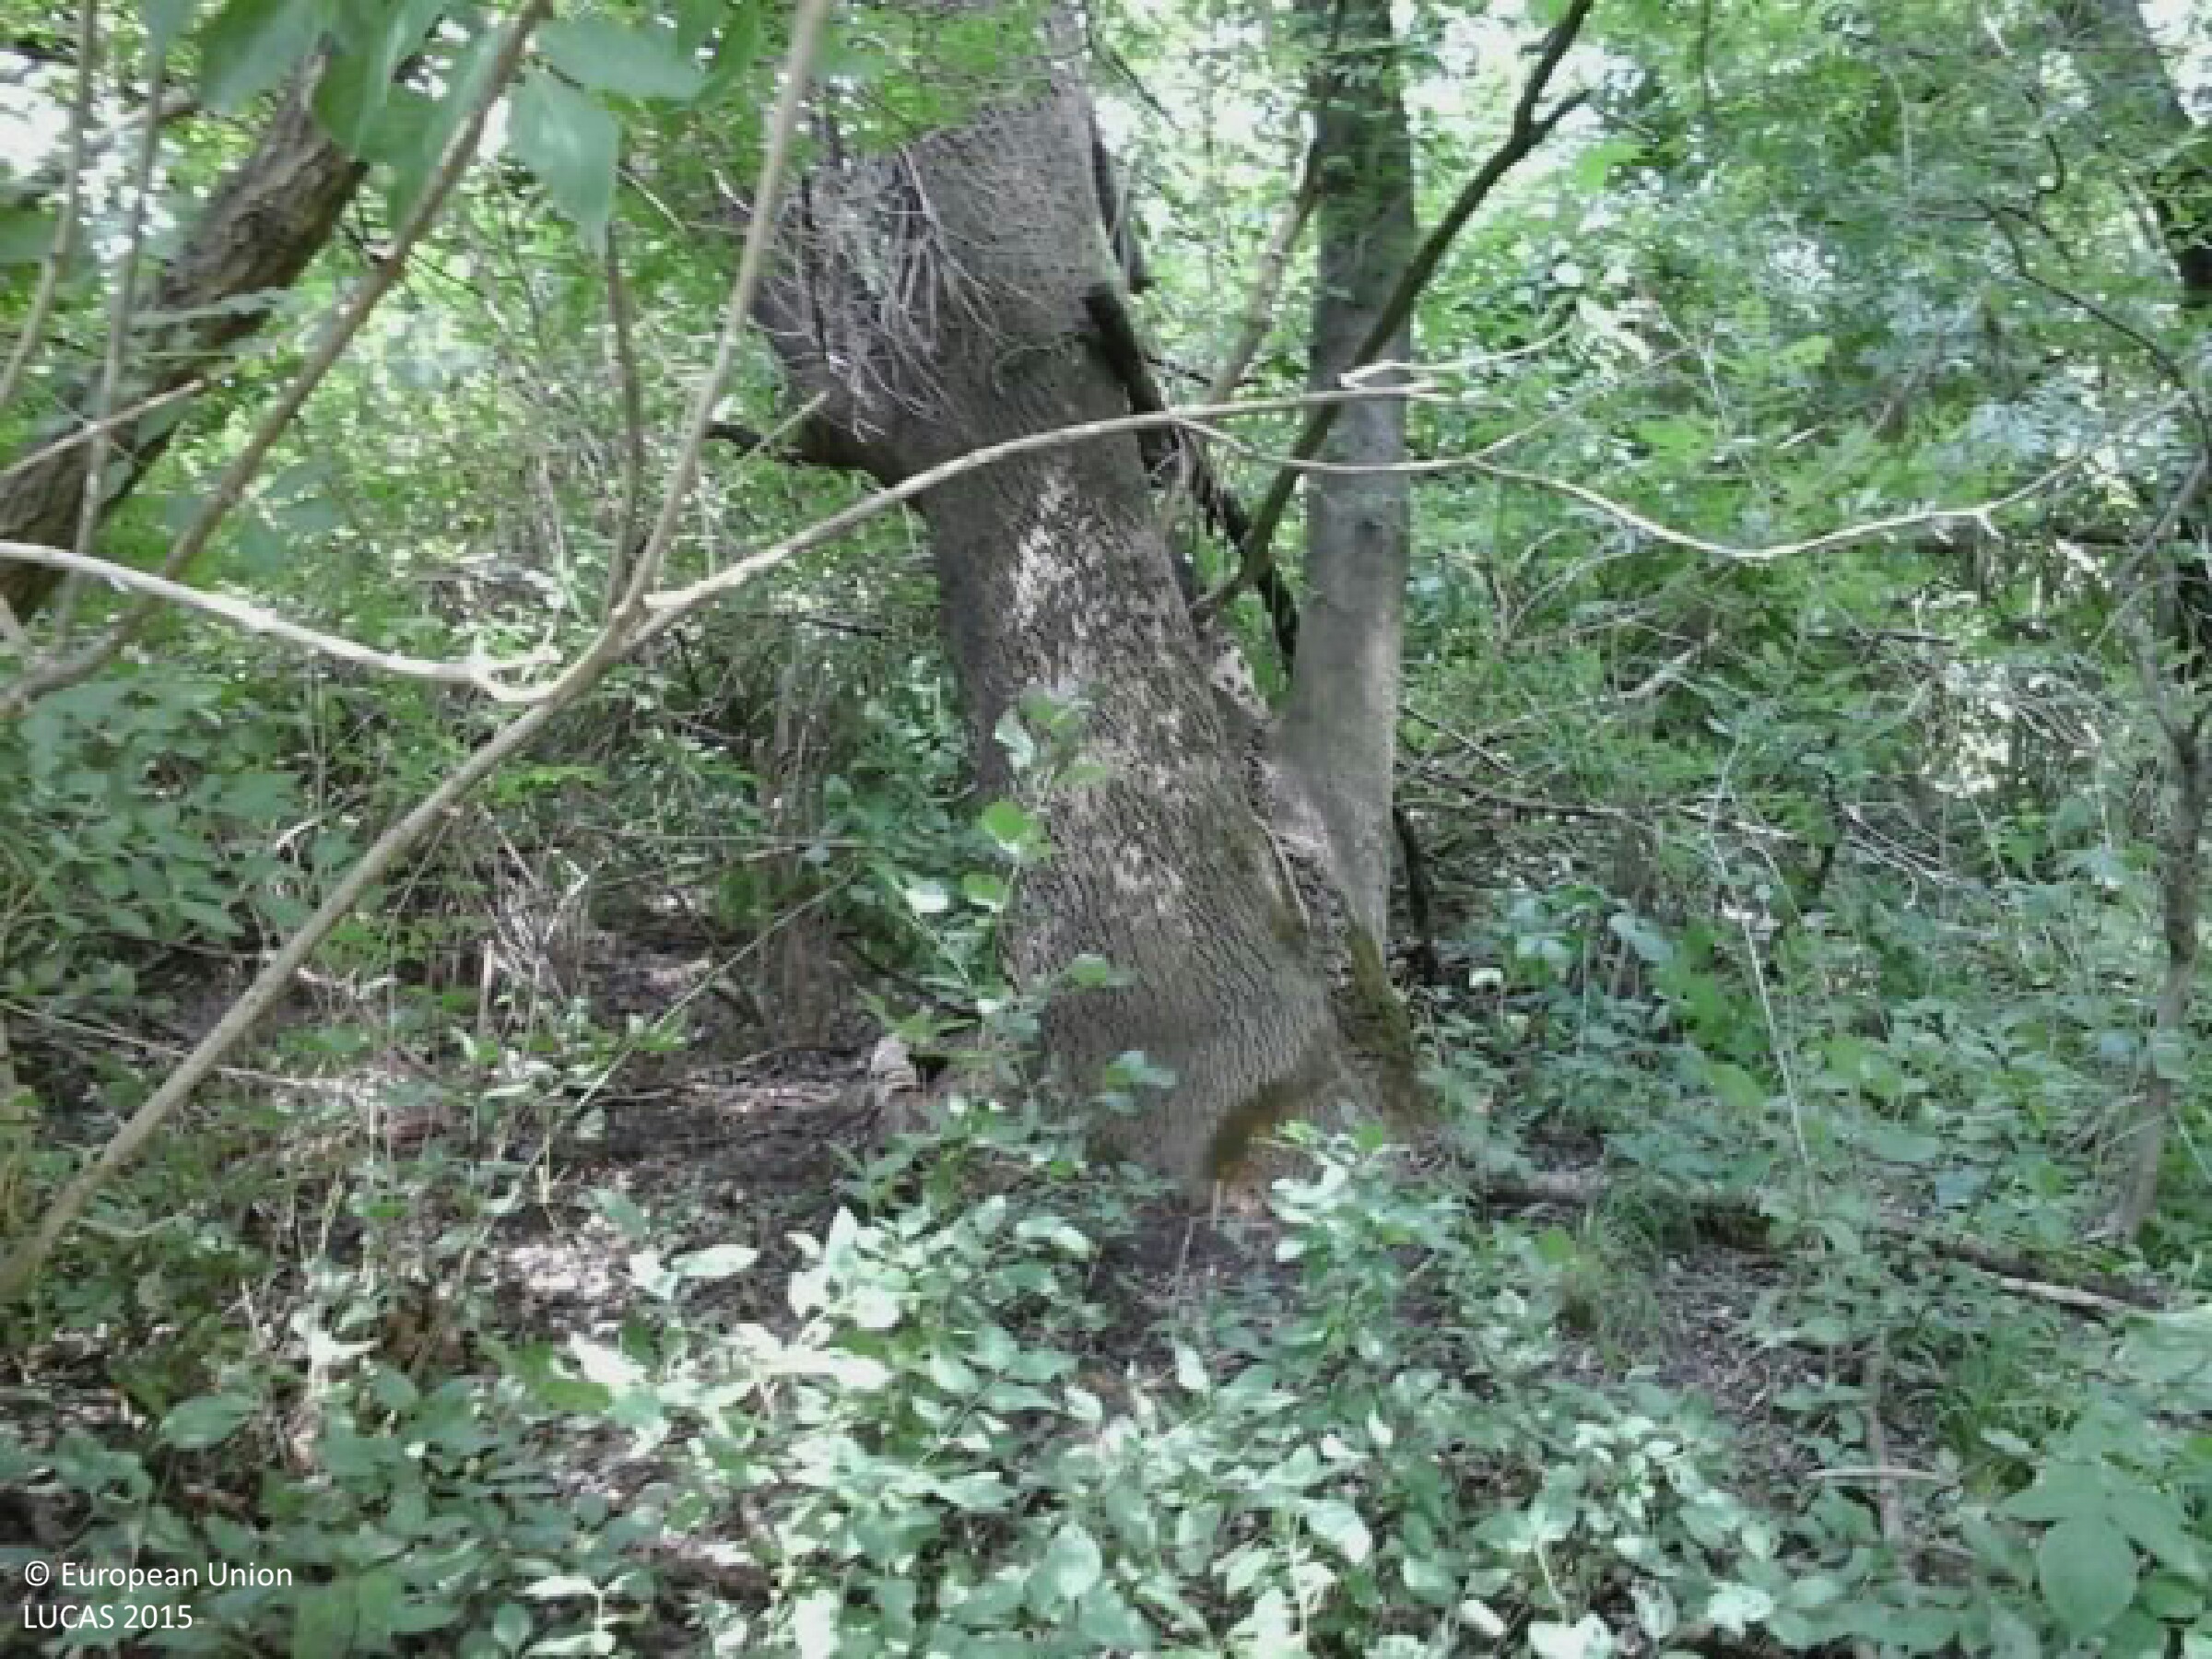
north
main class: Woodland
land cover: Broadleaved woodland
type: thermophilous deciduous forest
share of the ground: > 75 %
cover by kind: broadleaved forest trees 85 %, shrubs 10 %, herbaceous plants 5 %
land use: Forestry
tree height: > 5 m
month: July
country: HU
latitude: 47.2539
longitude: 19.2549
